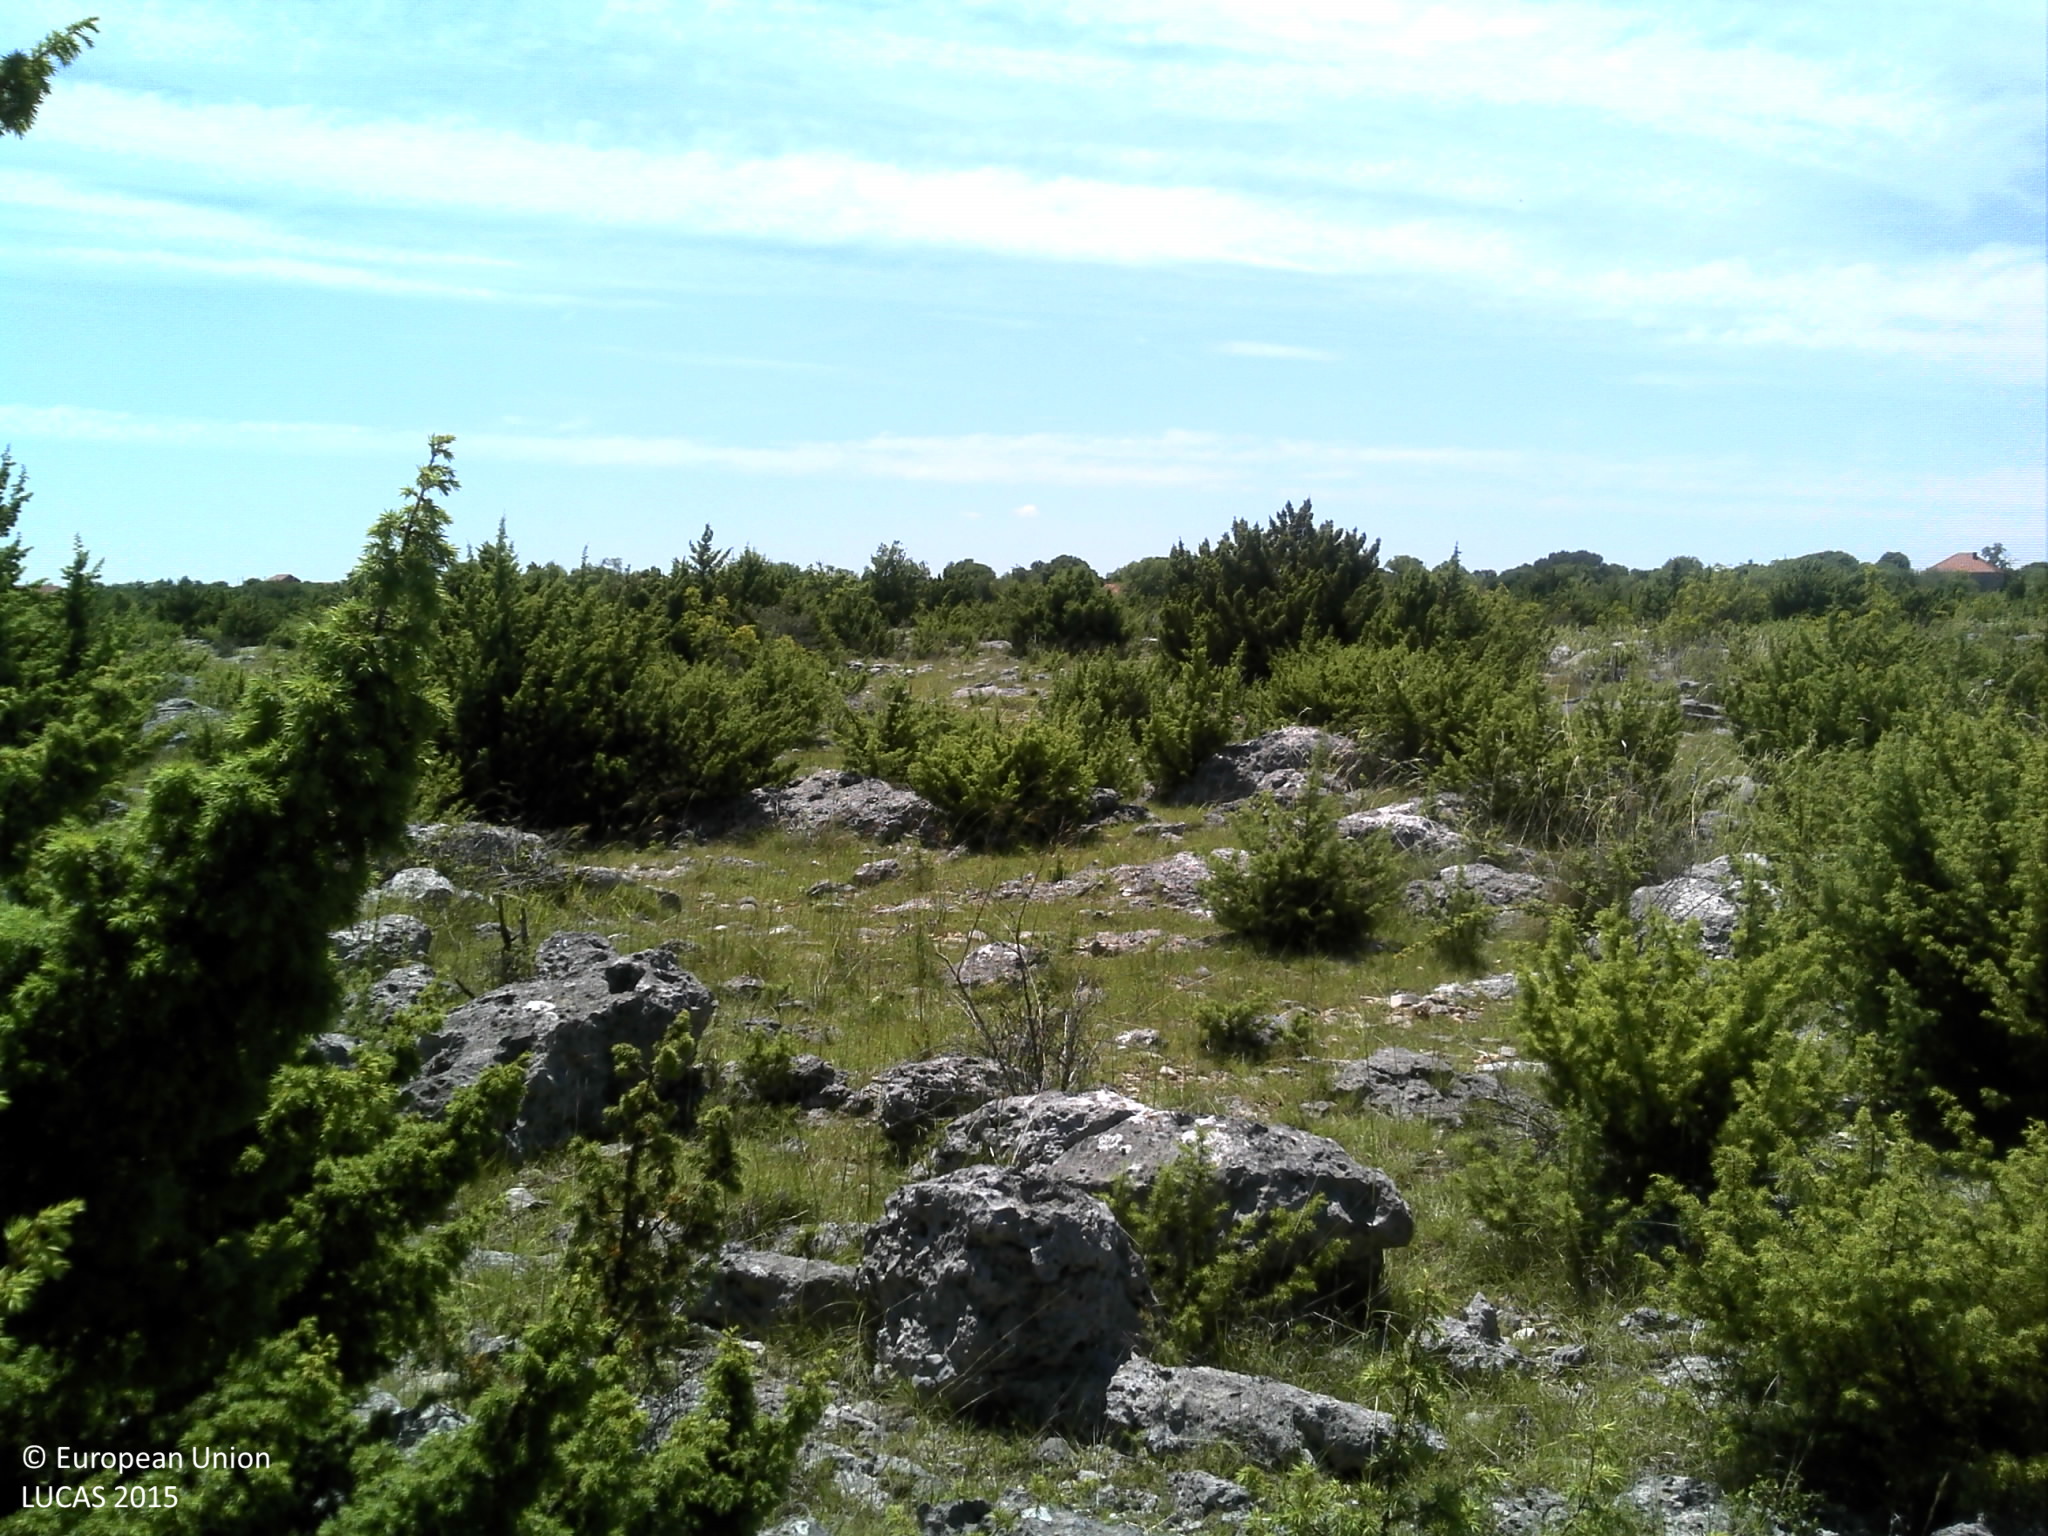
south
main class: Shrubland
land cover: Shrubland with sparse tree cover
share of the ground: 10 - 25 %
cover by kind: unconsolidated bare surface 35 %, herbaceous plants 30 %, shrubs 20 %, consolidated bare surface 10 %, coniferous forest trees 5 %
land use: Semi-natural and natural areas not in use
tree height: < 5 m
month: June
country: HR
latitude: 44.0146
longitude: 15.9921
